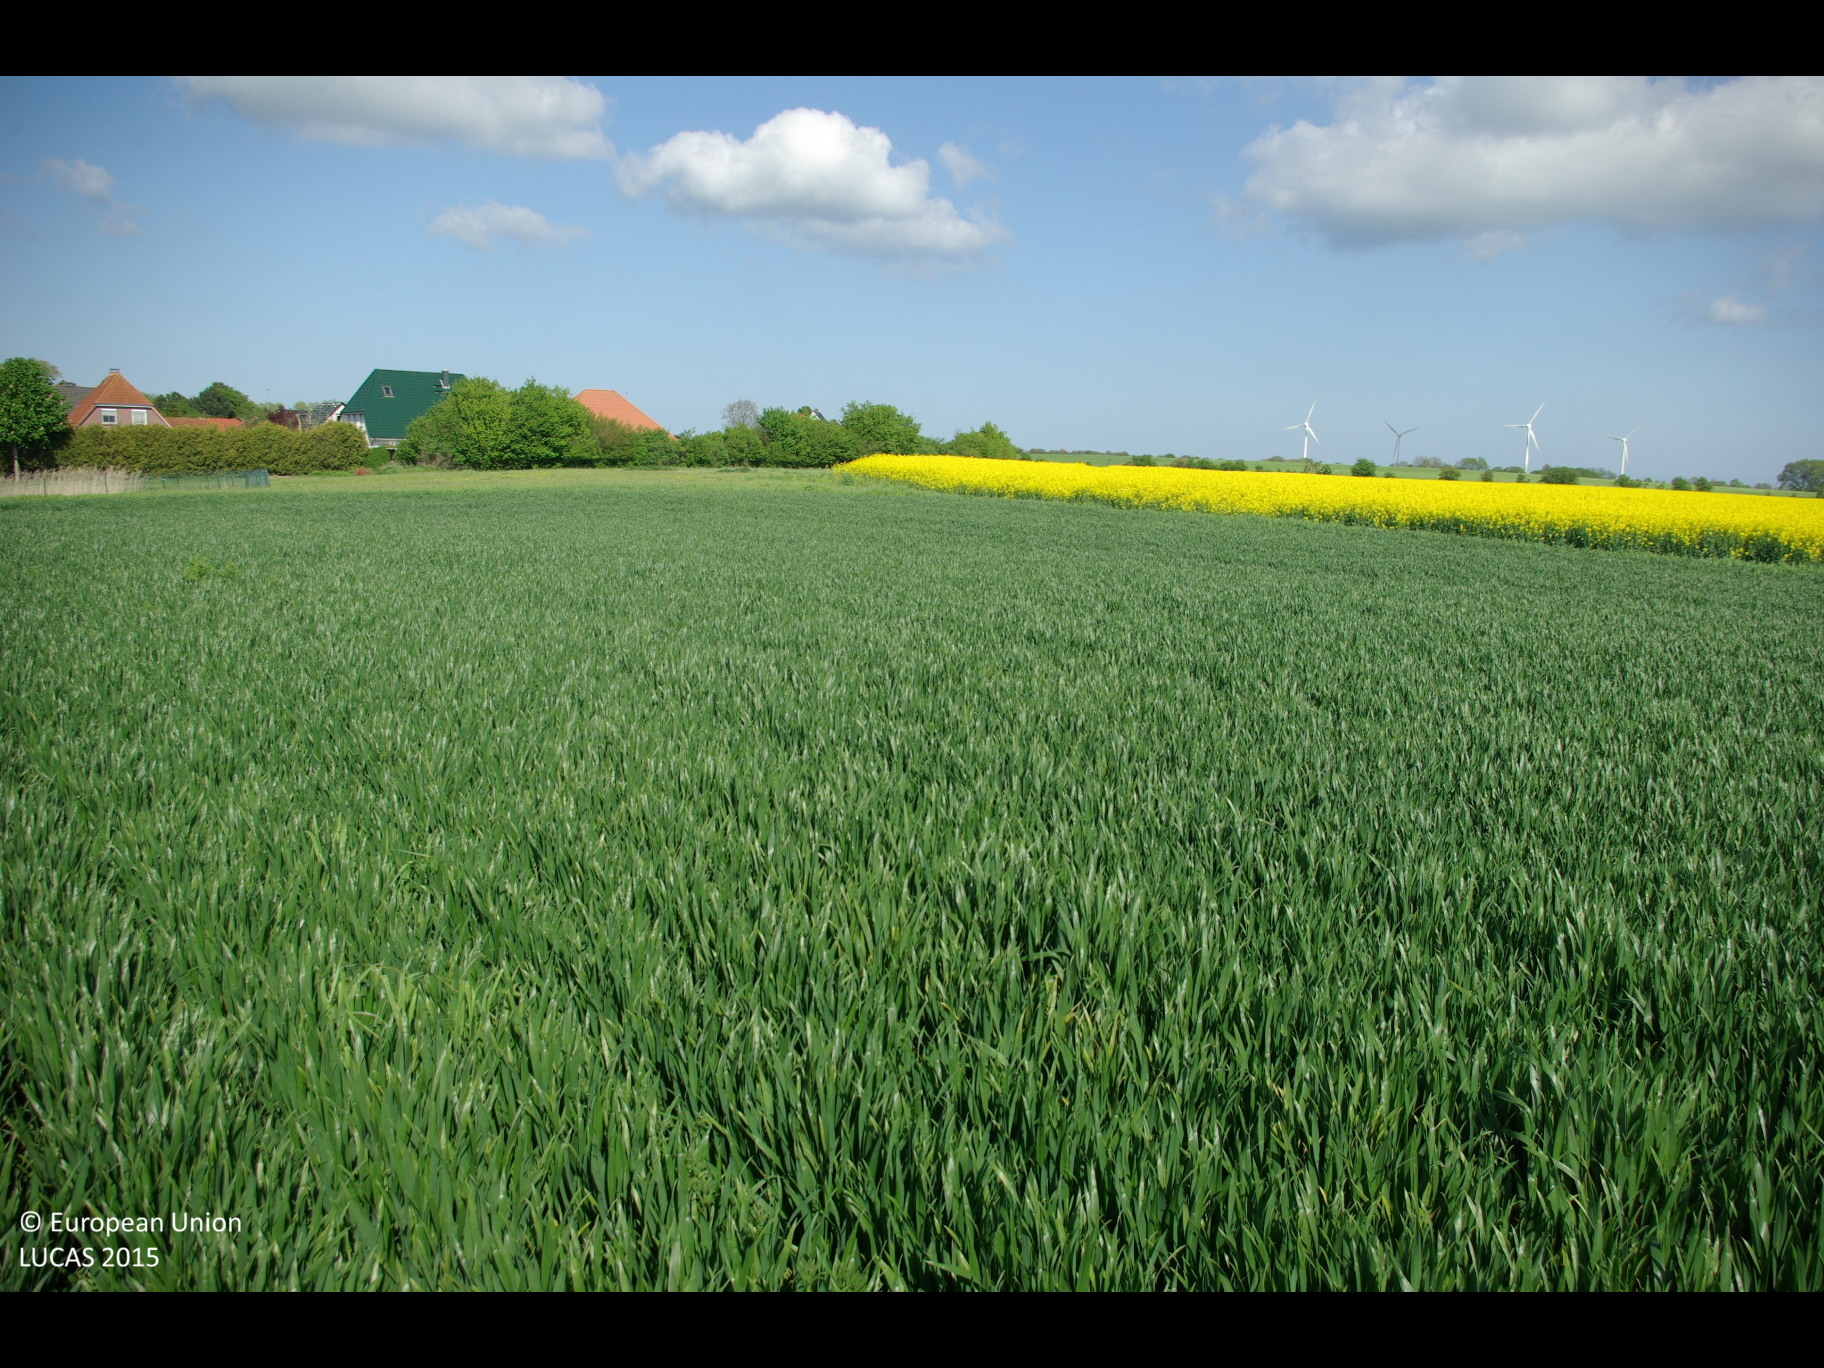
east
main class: Cropland
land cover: Common wheat
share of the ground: > 75 %
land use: Agriculture (excluding fallow land and kitchen gardens)
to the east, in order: Common wheat; Spontaneously vegetated surfaces; Rape and turnip rape
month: May
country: DE
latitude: 54.2965
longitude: 10.9981
